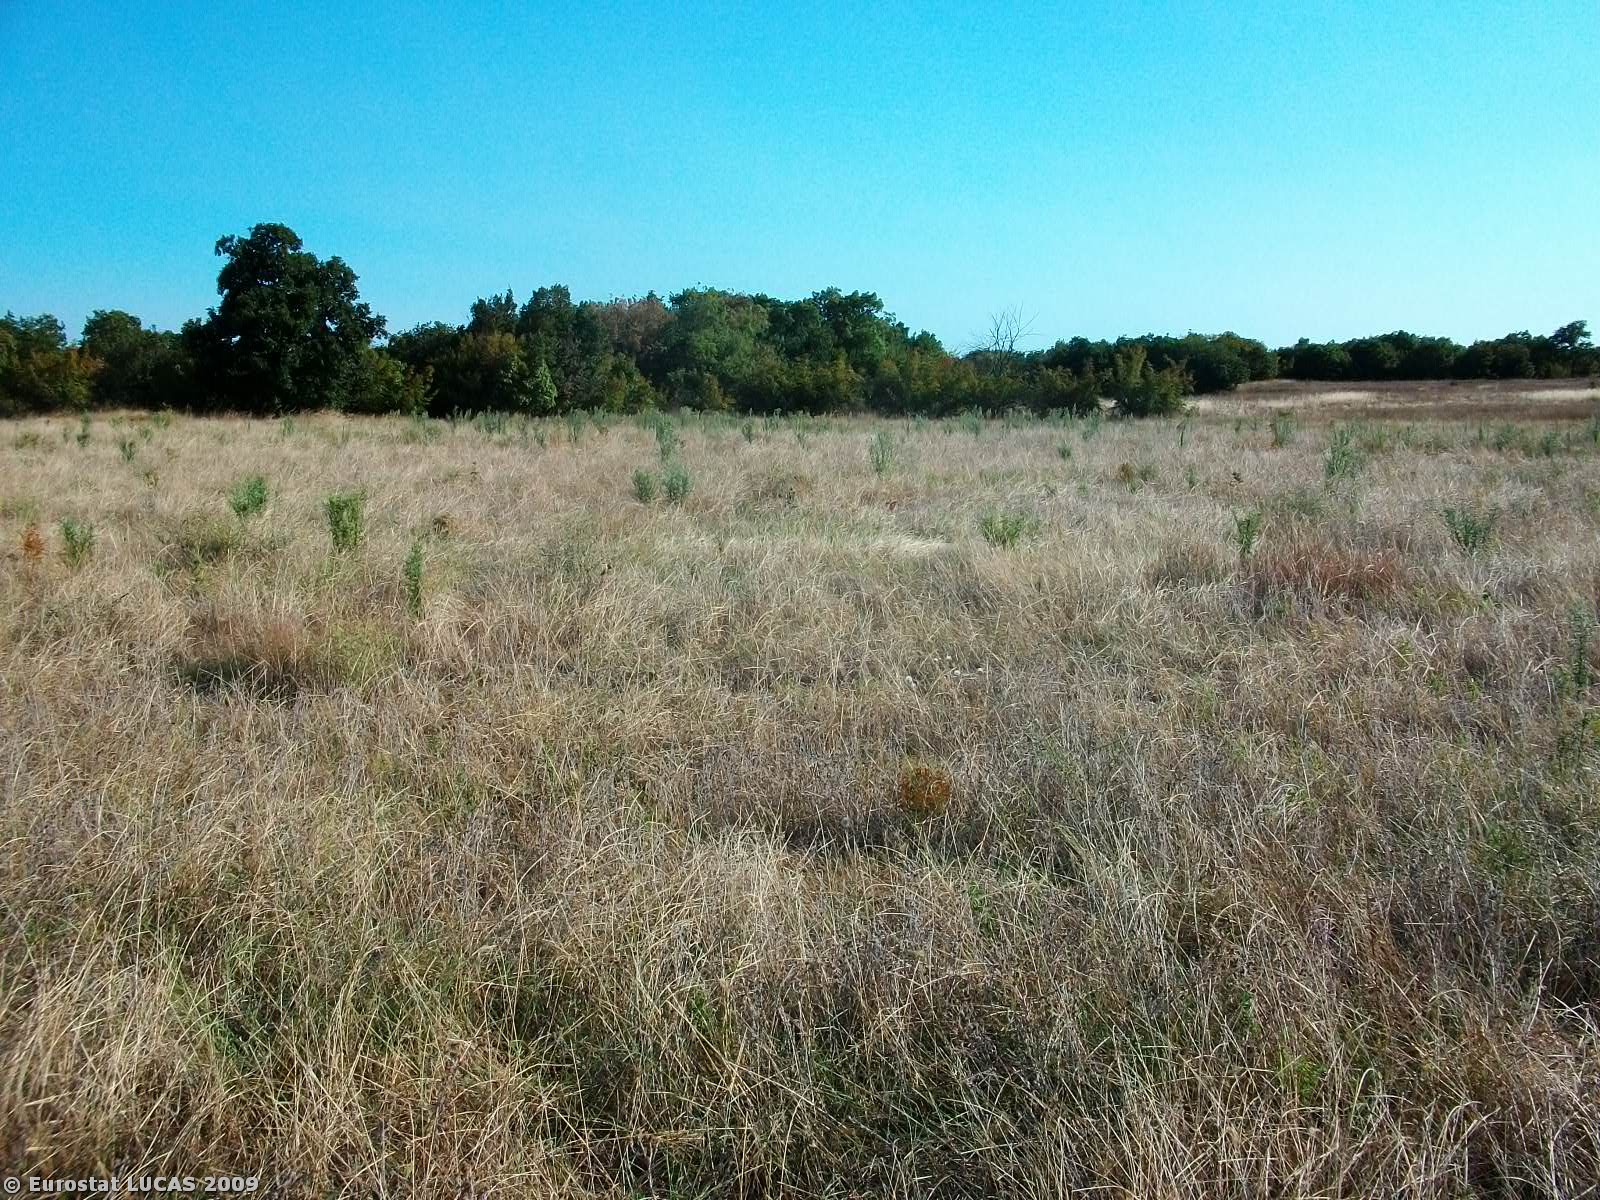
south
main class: Grassland
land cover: Grassland without tree/shrub cover
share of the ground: > 75 %
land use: Fallow land
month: August
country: GR
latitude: 41.3103
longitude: 26.3778
